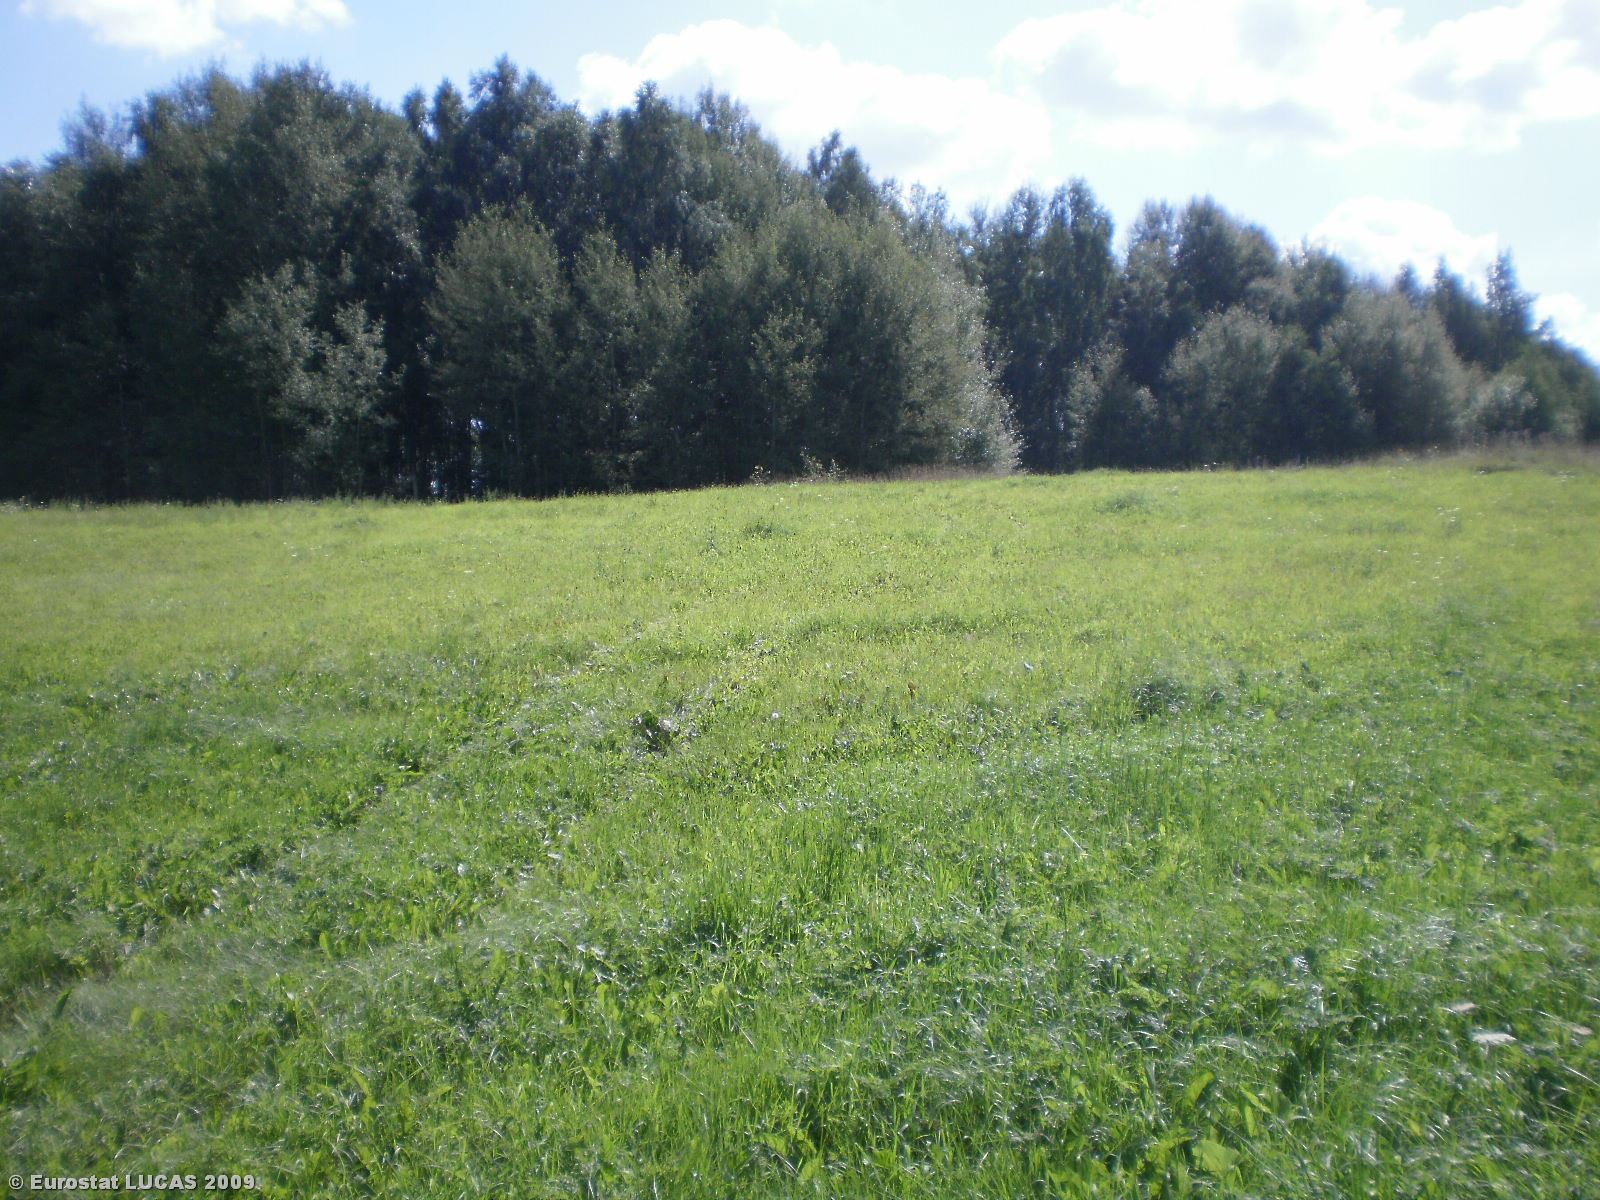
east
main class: Woodland
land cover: Coniferous woodland
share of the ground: 10 - 25 %
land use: Forestry
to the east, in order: Coniferous woodland; Grassland without tree/shrub cover; Common wheat
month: August
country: LT
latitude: 55.7833
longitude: 25.0857
